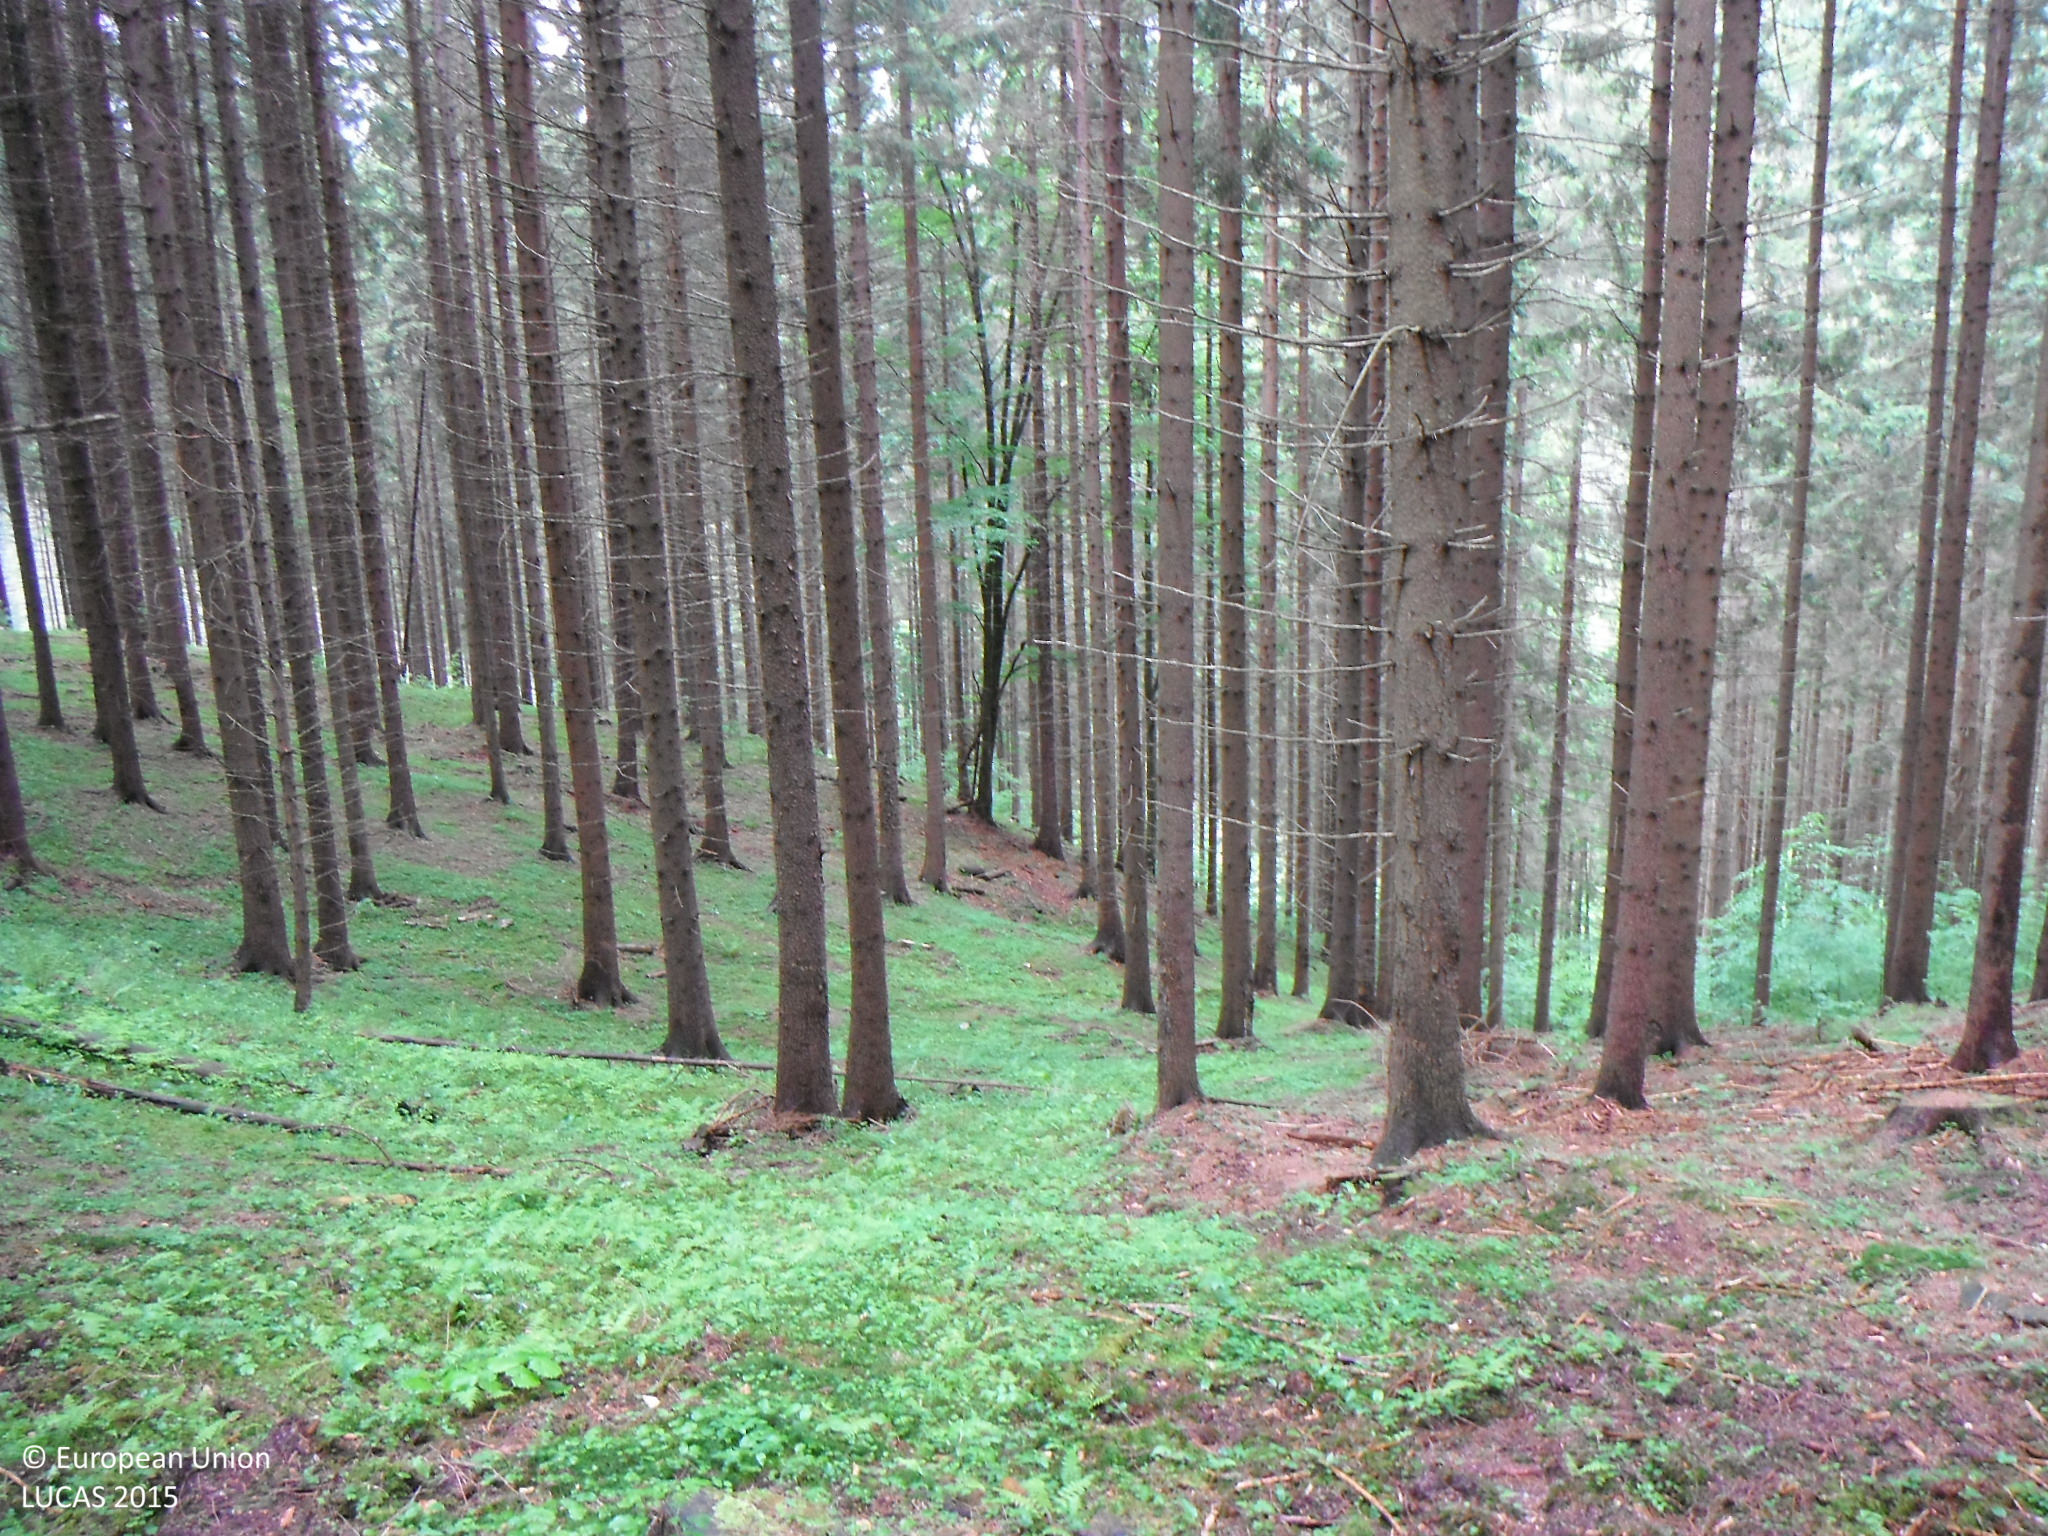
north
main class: Woodland
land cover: Spruce dominated coniferous woodland
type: alpine coniferous forest
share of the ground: > 75 %
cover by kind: coniferous forest trees 100 %
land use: Forestry
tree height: > 5 m
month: May
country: SK
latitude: 48.9929
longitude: 19.0283
